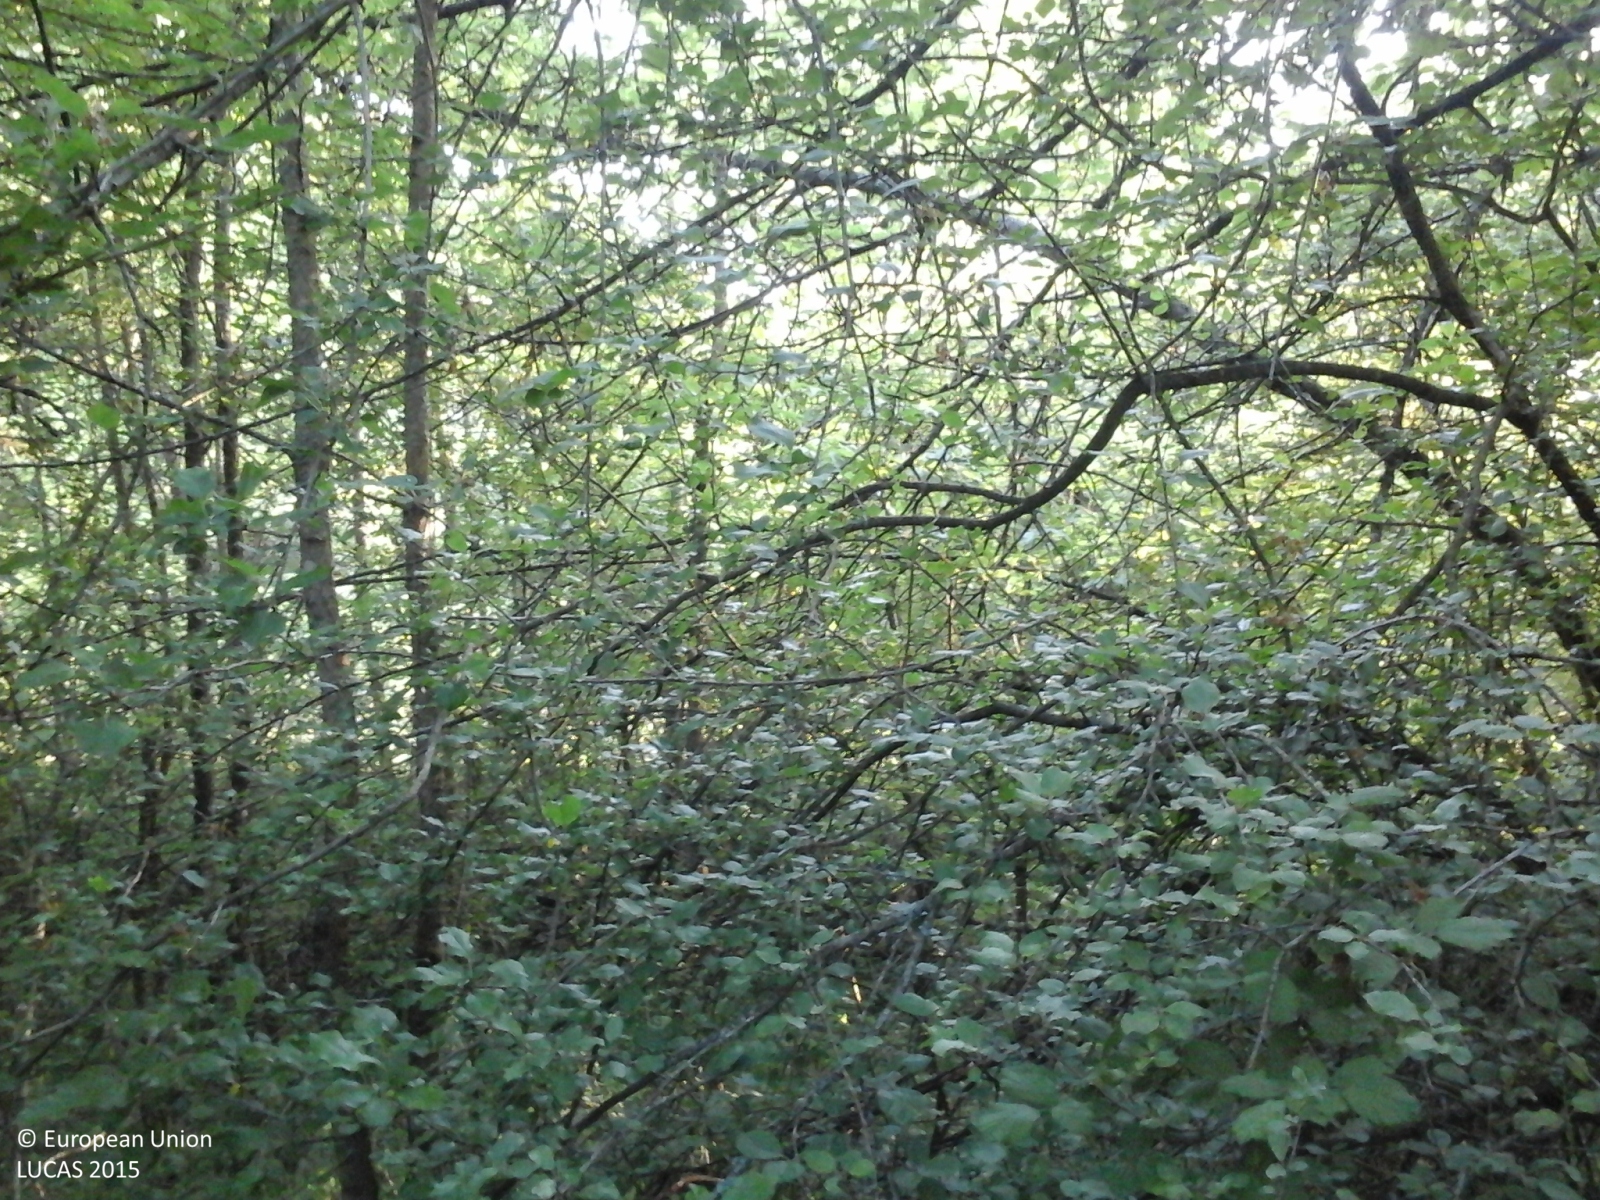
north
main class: Woodland
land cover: Broadleaved woodland
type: thermophilous deciduous forest
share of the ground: > 75 %
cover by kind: broadleaved forest trees 70 %, shrubs 30 %
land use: Forestry
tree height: > 5 m
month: May
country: IT
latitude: 44.5845
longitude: 9.6858
